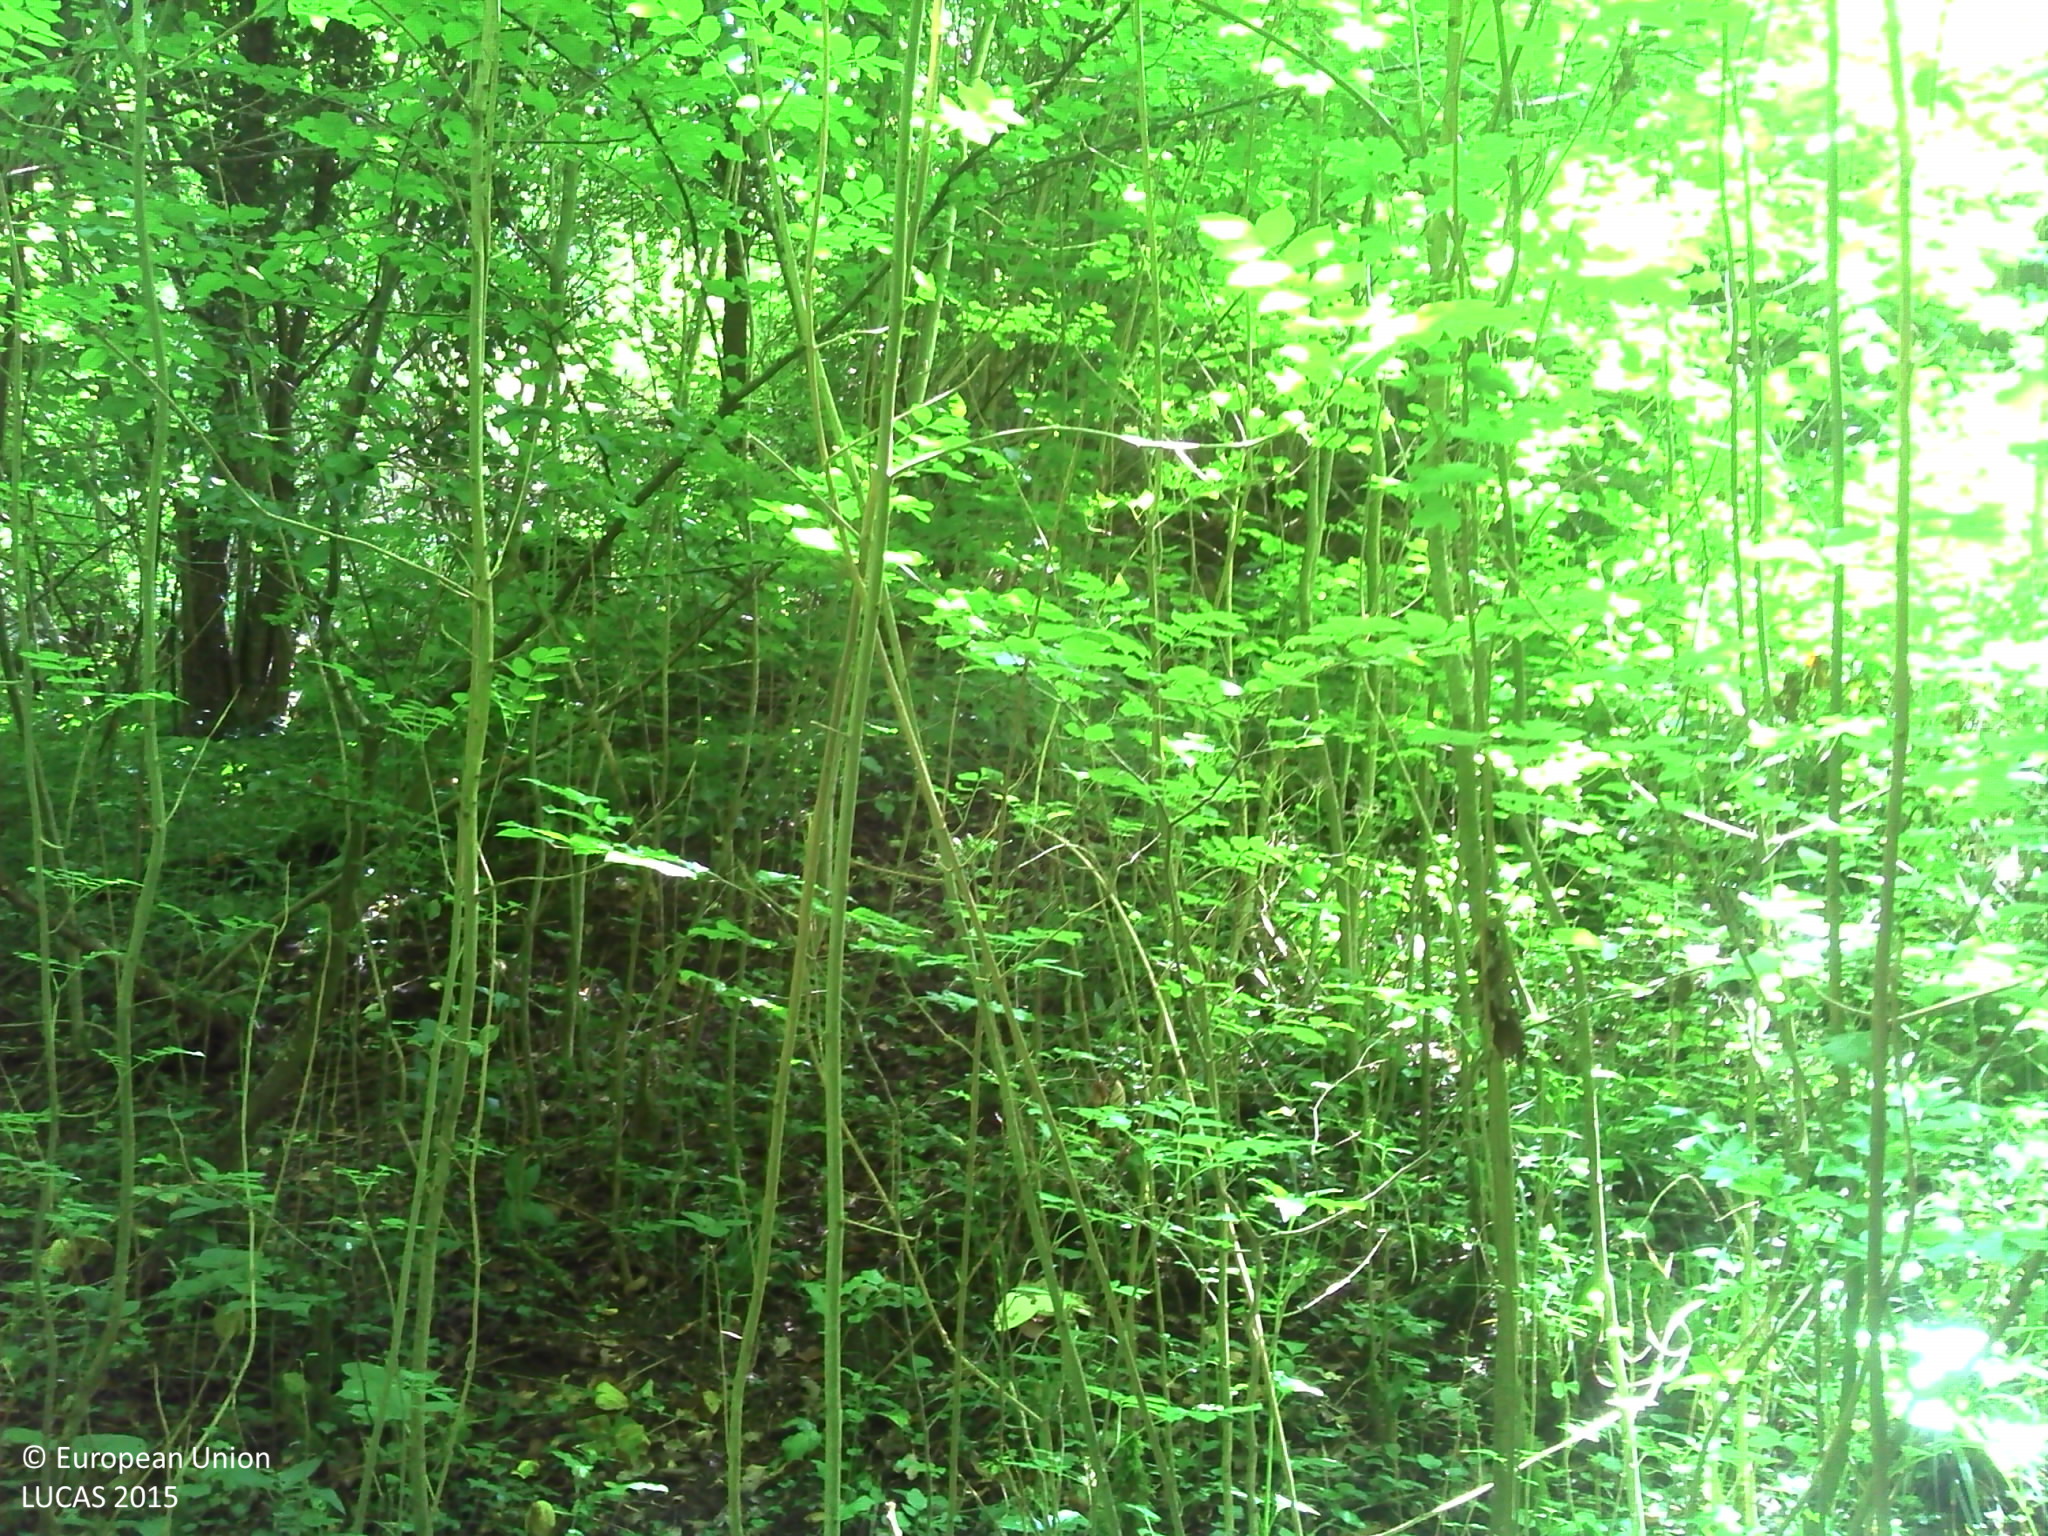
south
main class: Woodland
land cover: Broadleaved woodland
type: mesophytic deciduous forest
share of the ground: > 75 %
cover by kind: broadleaved forest trees 85 %, herbaceous plants 10 %, lichens and mosses 5 %
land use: Forestry
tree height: > 5 m
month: June
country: FR
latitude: 49.2336
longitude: 1.0379
